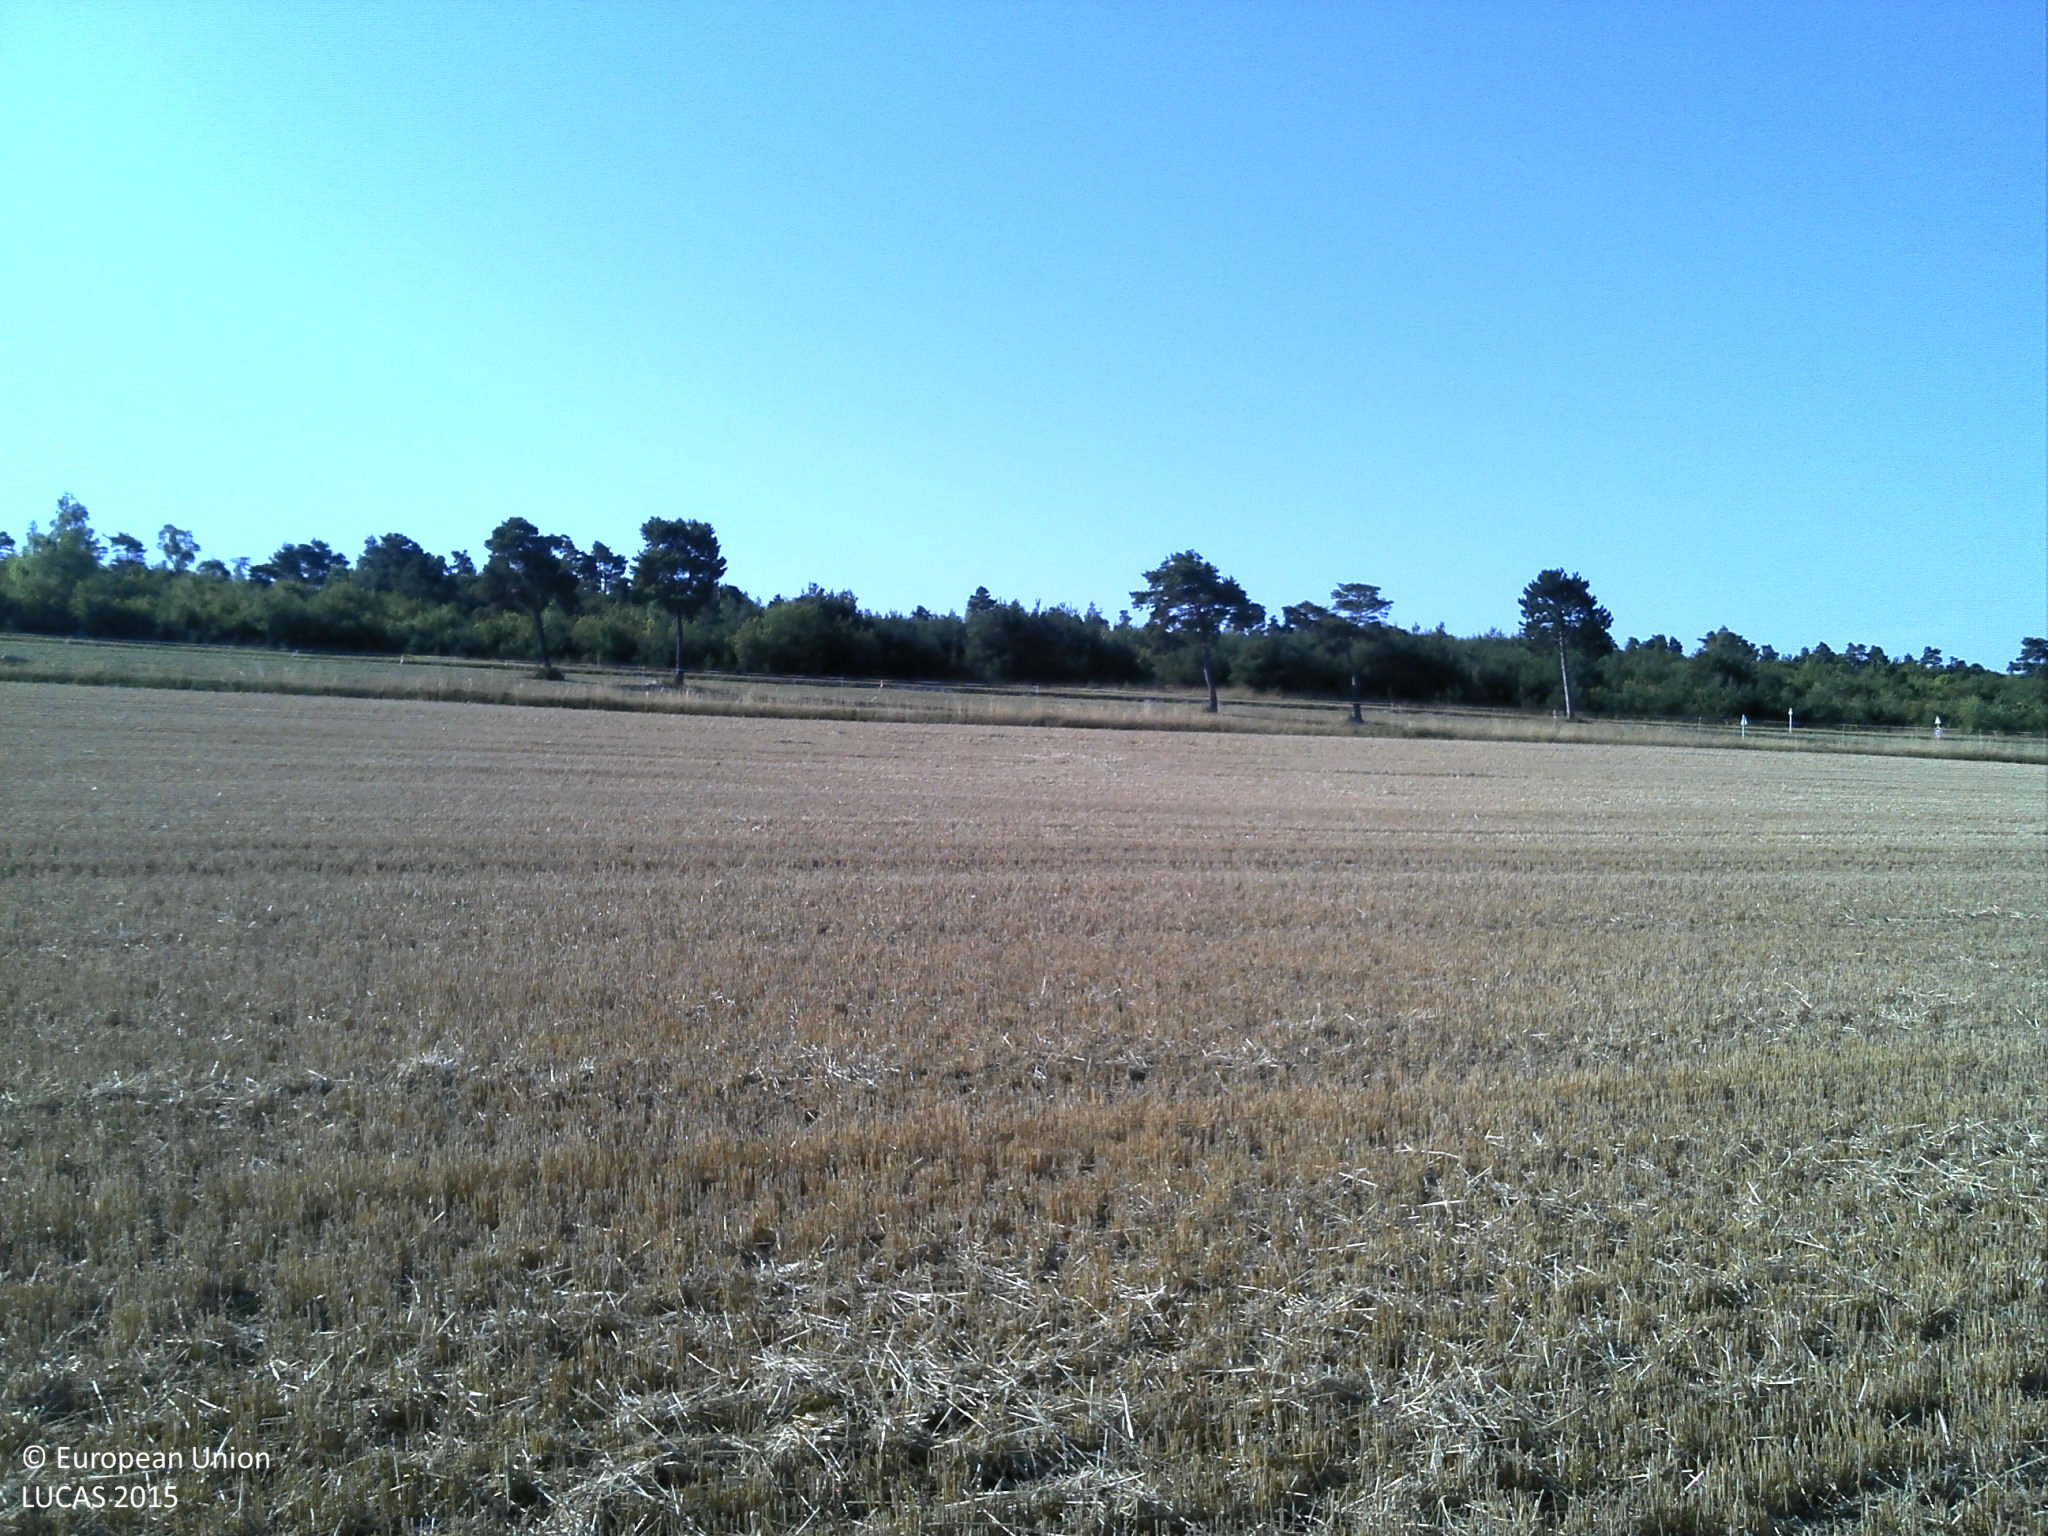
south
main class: Cropland
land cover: Barley
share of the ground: > 75 %
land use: Agriculture (excluding fallow land and kitchen gardens)
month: August
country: FR
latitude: 48.6151
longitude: 4.2586
